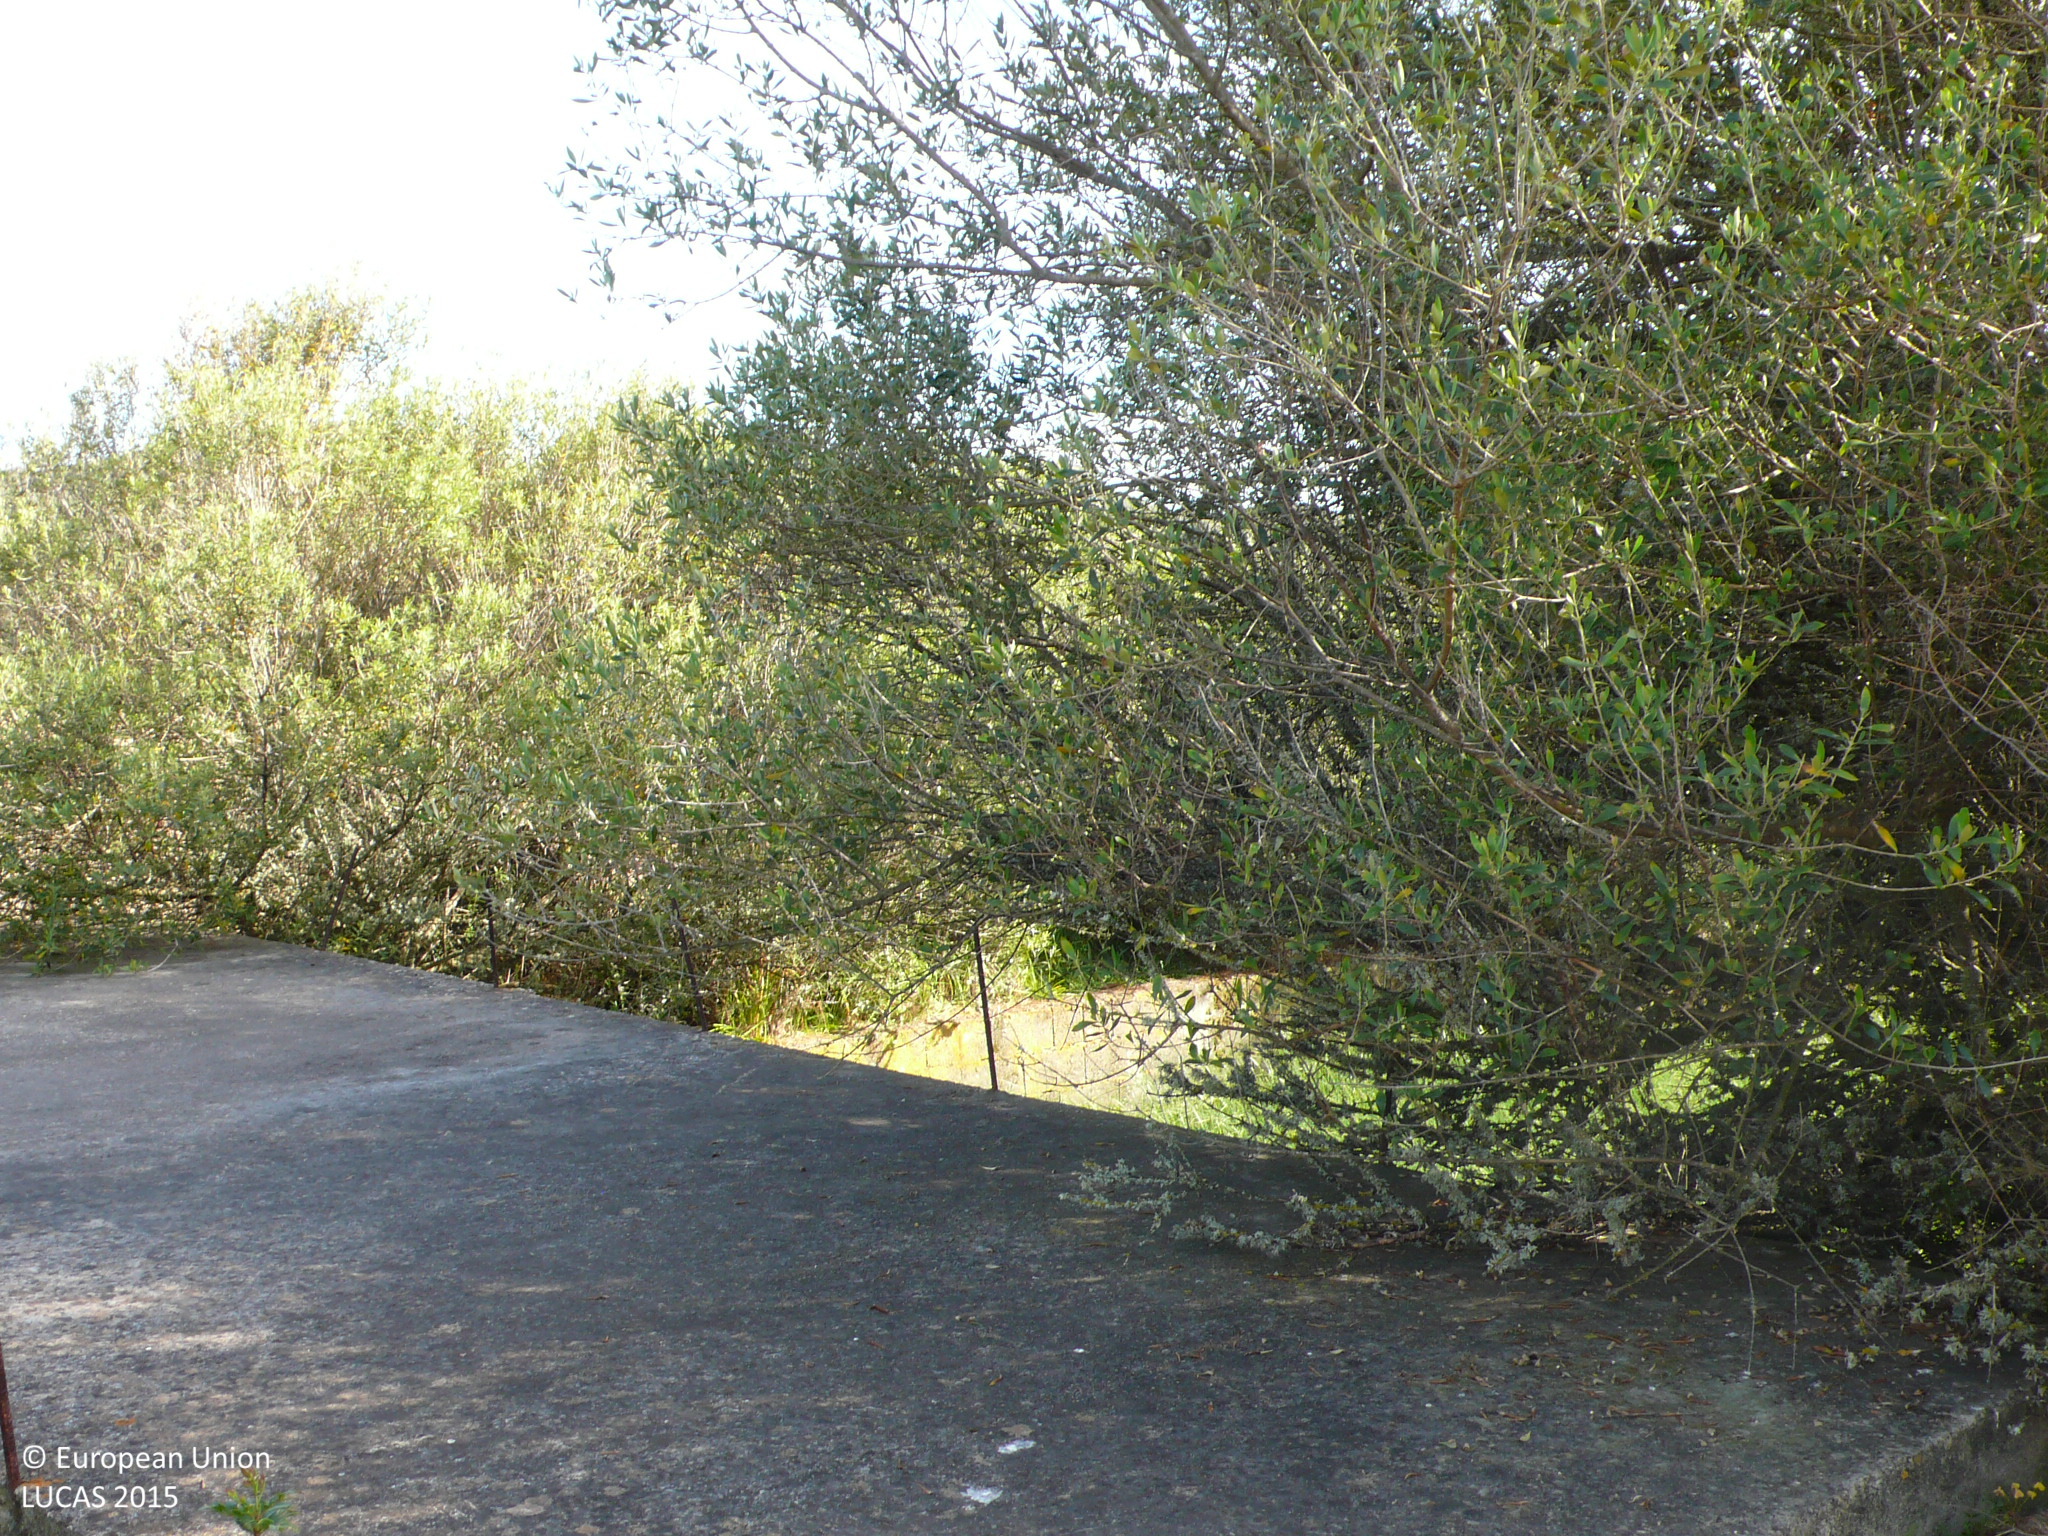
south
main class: Cropland
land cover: Mixed cereals for fodder
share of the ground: < 10 %
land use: Agriculture (excluding fallow land and kitchen gardens)
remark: Harvested field
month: May
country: ES
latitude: 39.9357
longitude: 4.2566
